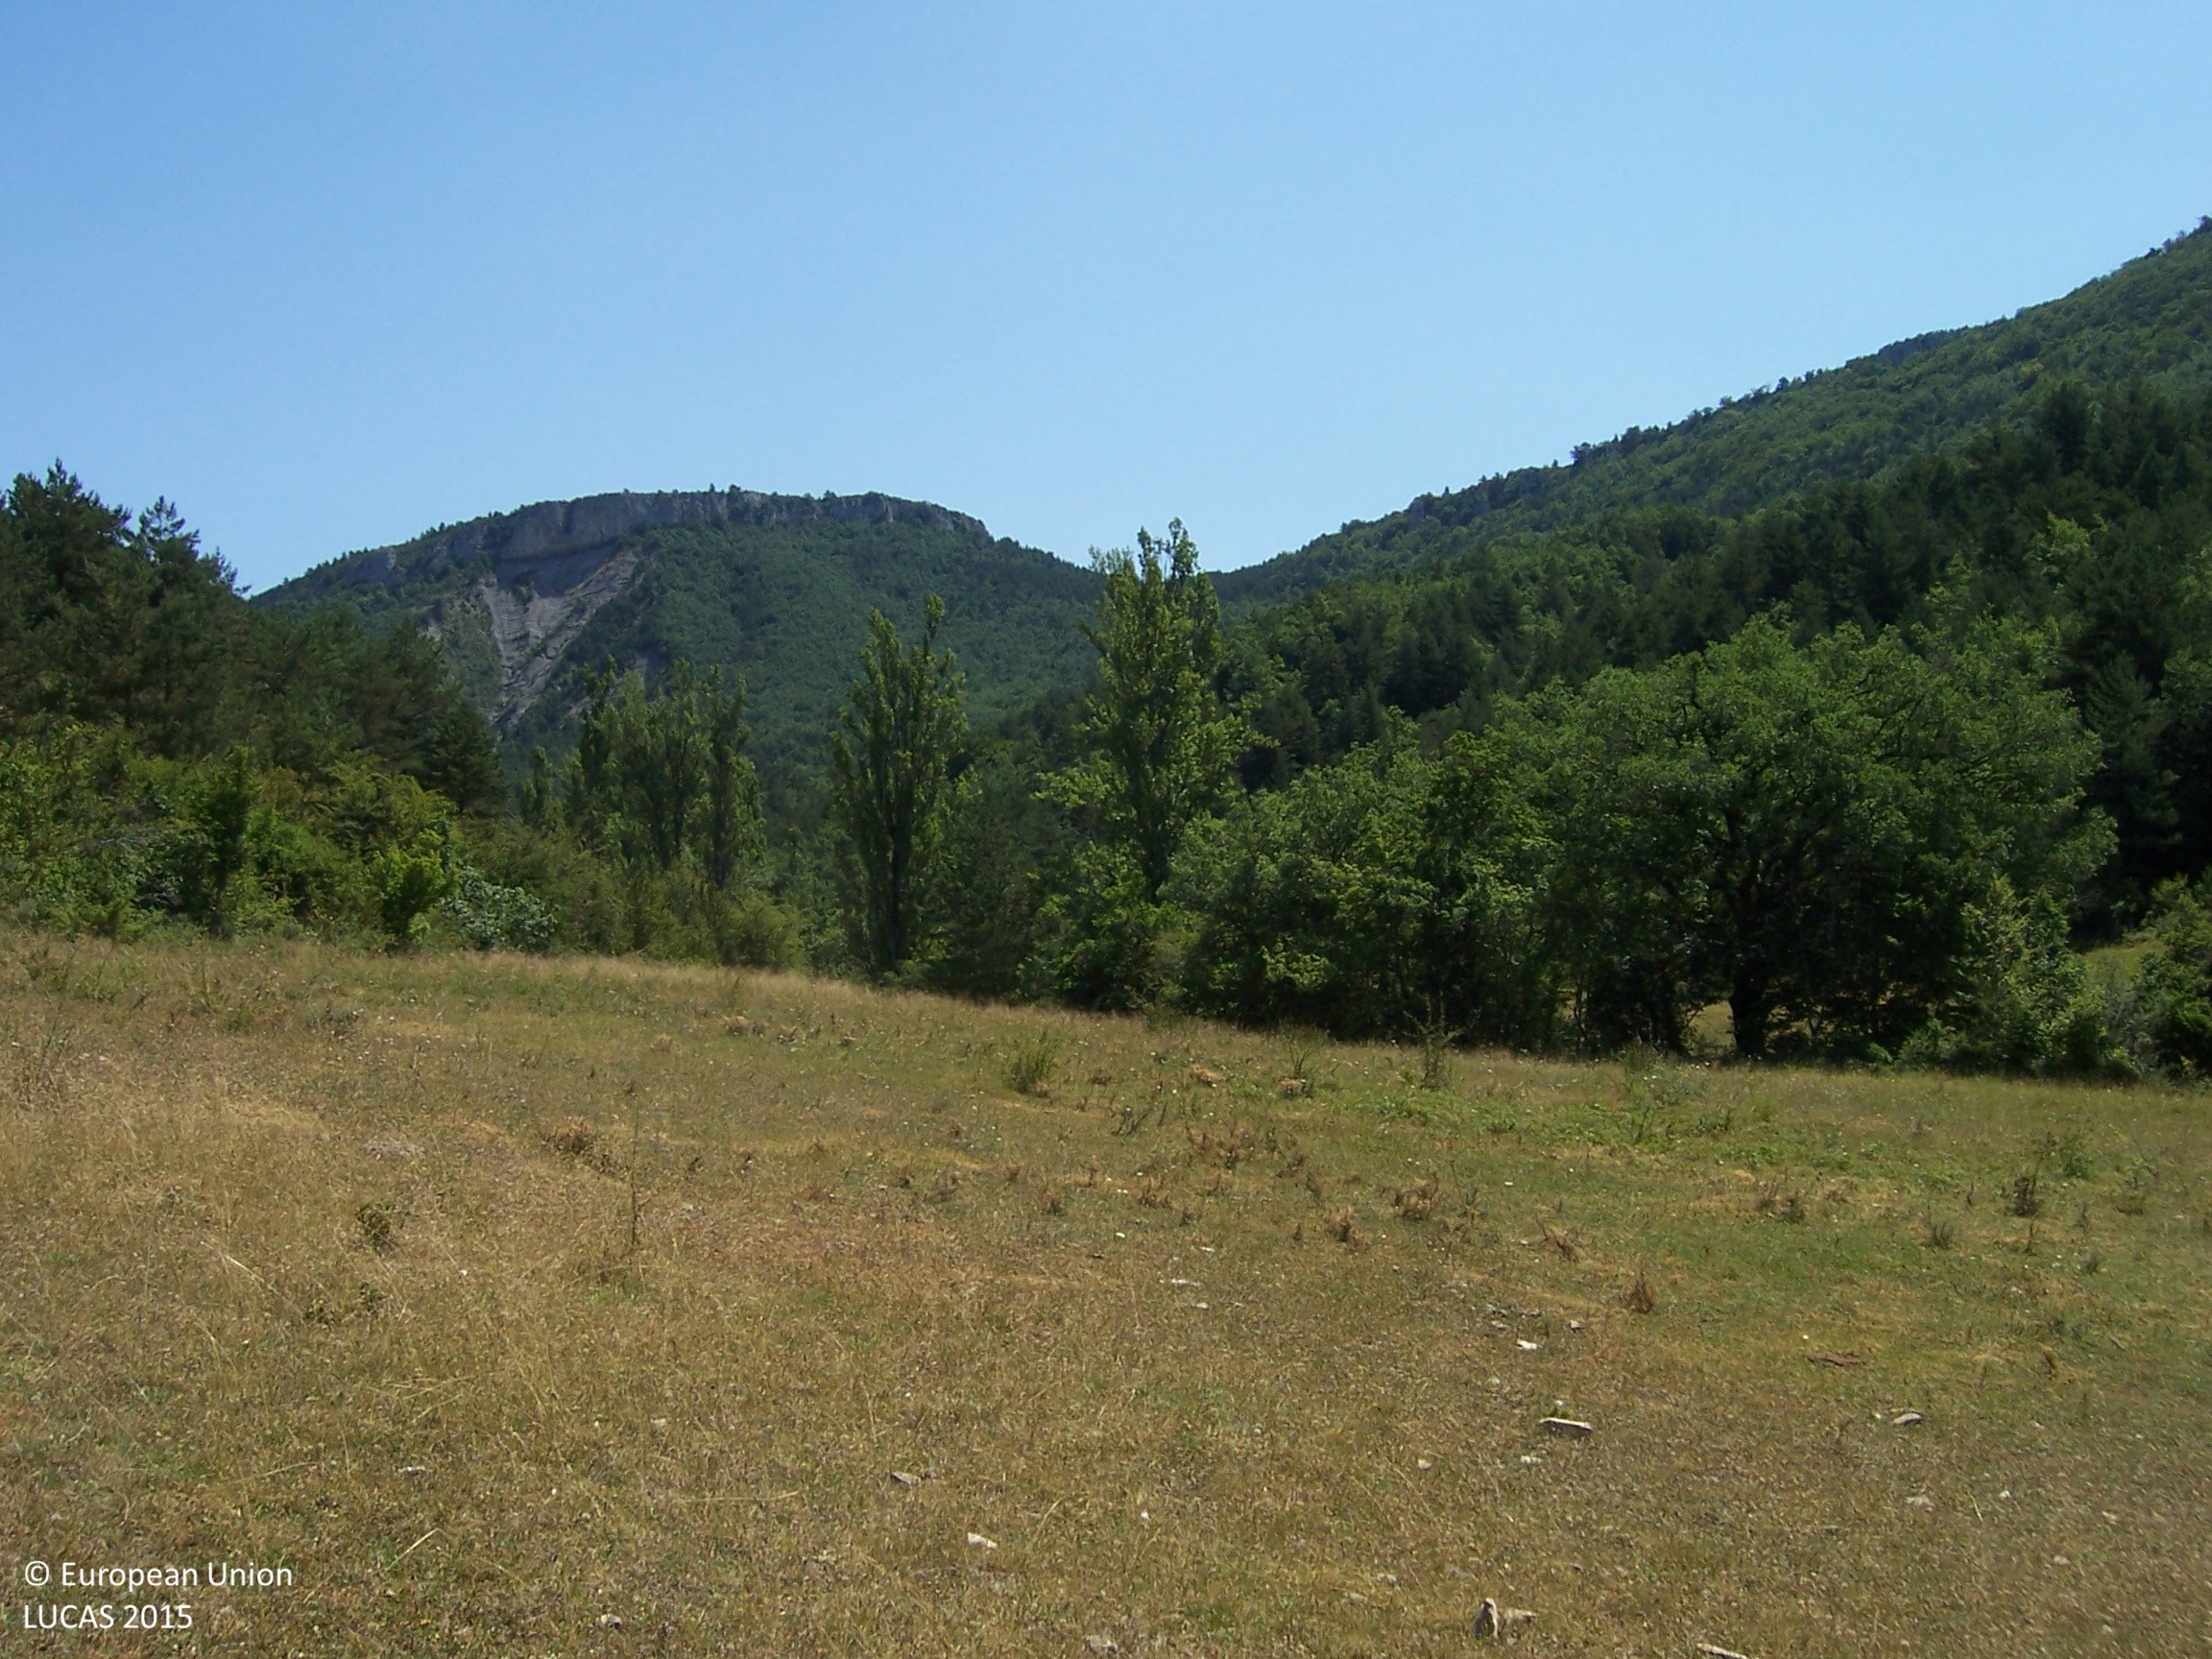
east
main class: Woodland
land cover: Broadleaved woodland
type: acidophilous oak and oak-birch forest
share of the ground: > 75 %
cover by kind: broadleaved forest trees 100 %
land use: Forestry
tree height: > 5 m
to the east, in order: Broadleaved woodland
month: July
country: ES
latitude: 42.8166
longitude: -1.1764
